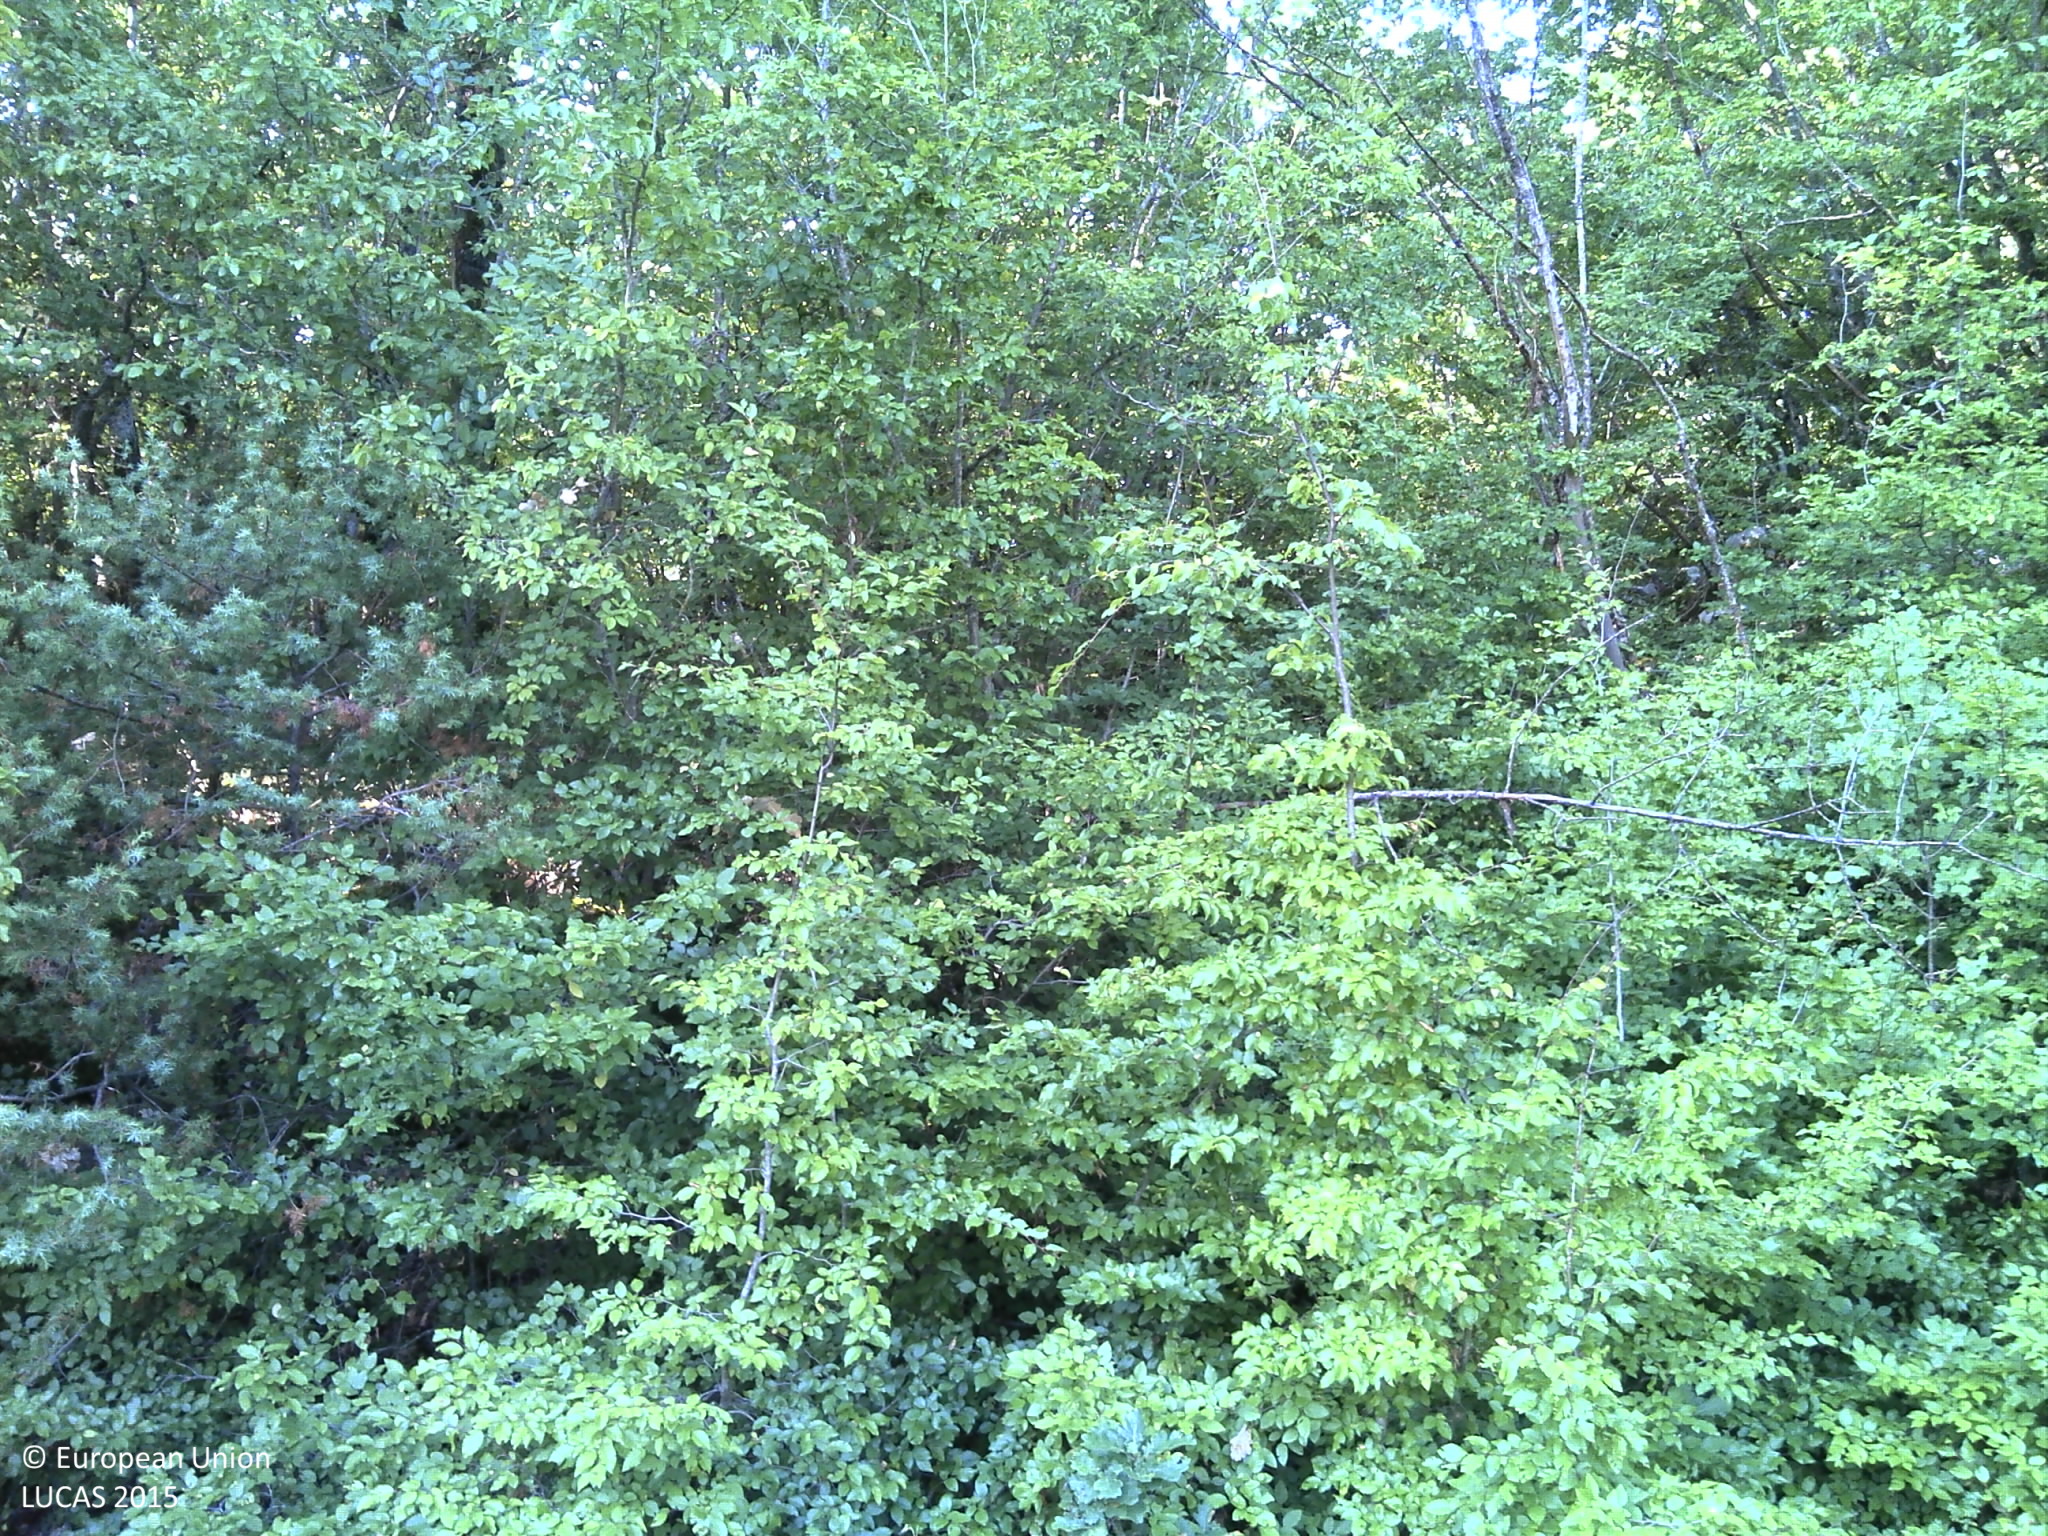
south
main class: Woodland
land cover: Other mixed woodland
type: thermophilous deciduous forest
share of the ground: > 75 %
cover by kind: broadleaved forest trees 30 %, shrubs 30 %, herbaceous plants 15 %, coniferous forest trees 10 %, unconsolidated bare surface 10 %, consolidated bare surface 5 %
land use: Semi-natural and natural areas not in use
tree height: > 5 m
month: August
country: HR
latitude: 43.3427
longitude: 17.1582
